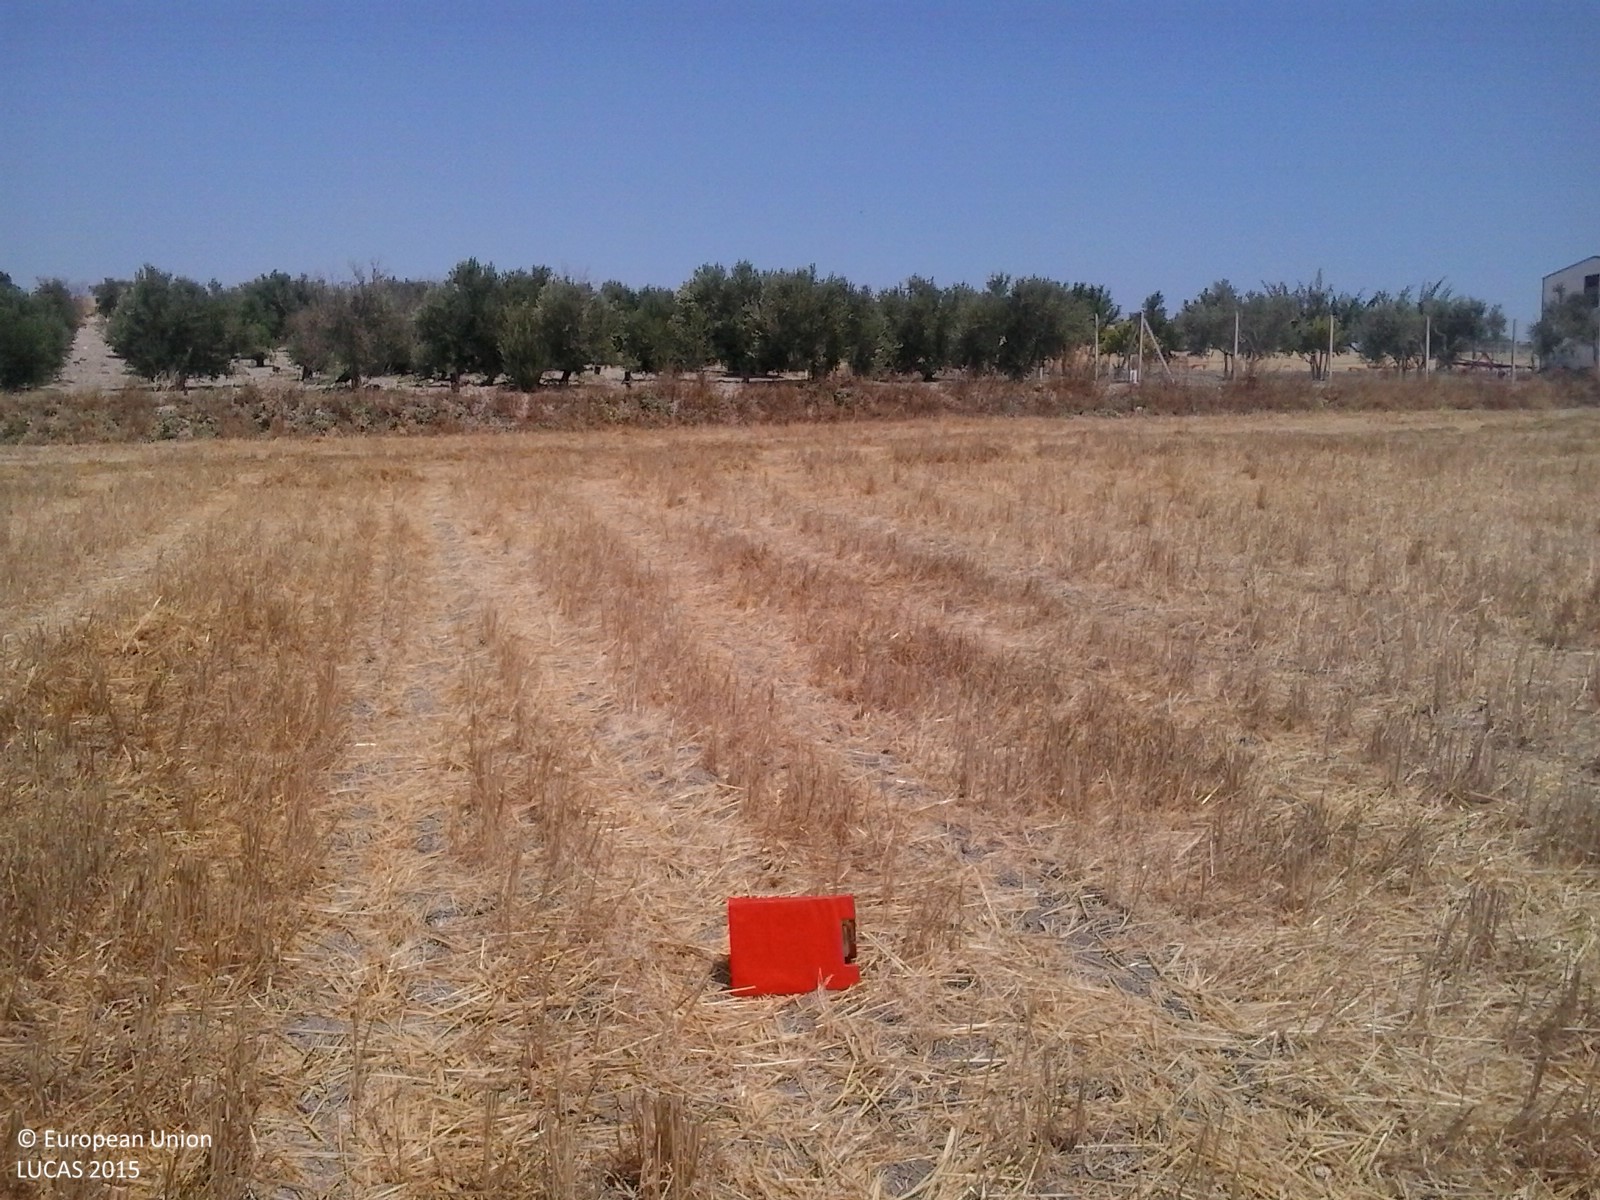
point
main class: Cropland
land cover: Common wheat
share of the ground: < 10 %
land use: Agriculture (excluding fallow land and kitchen gardens)
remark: Harvested field
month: July
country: ES
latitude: 36.9341
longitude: -6.0142
